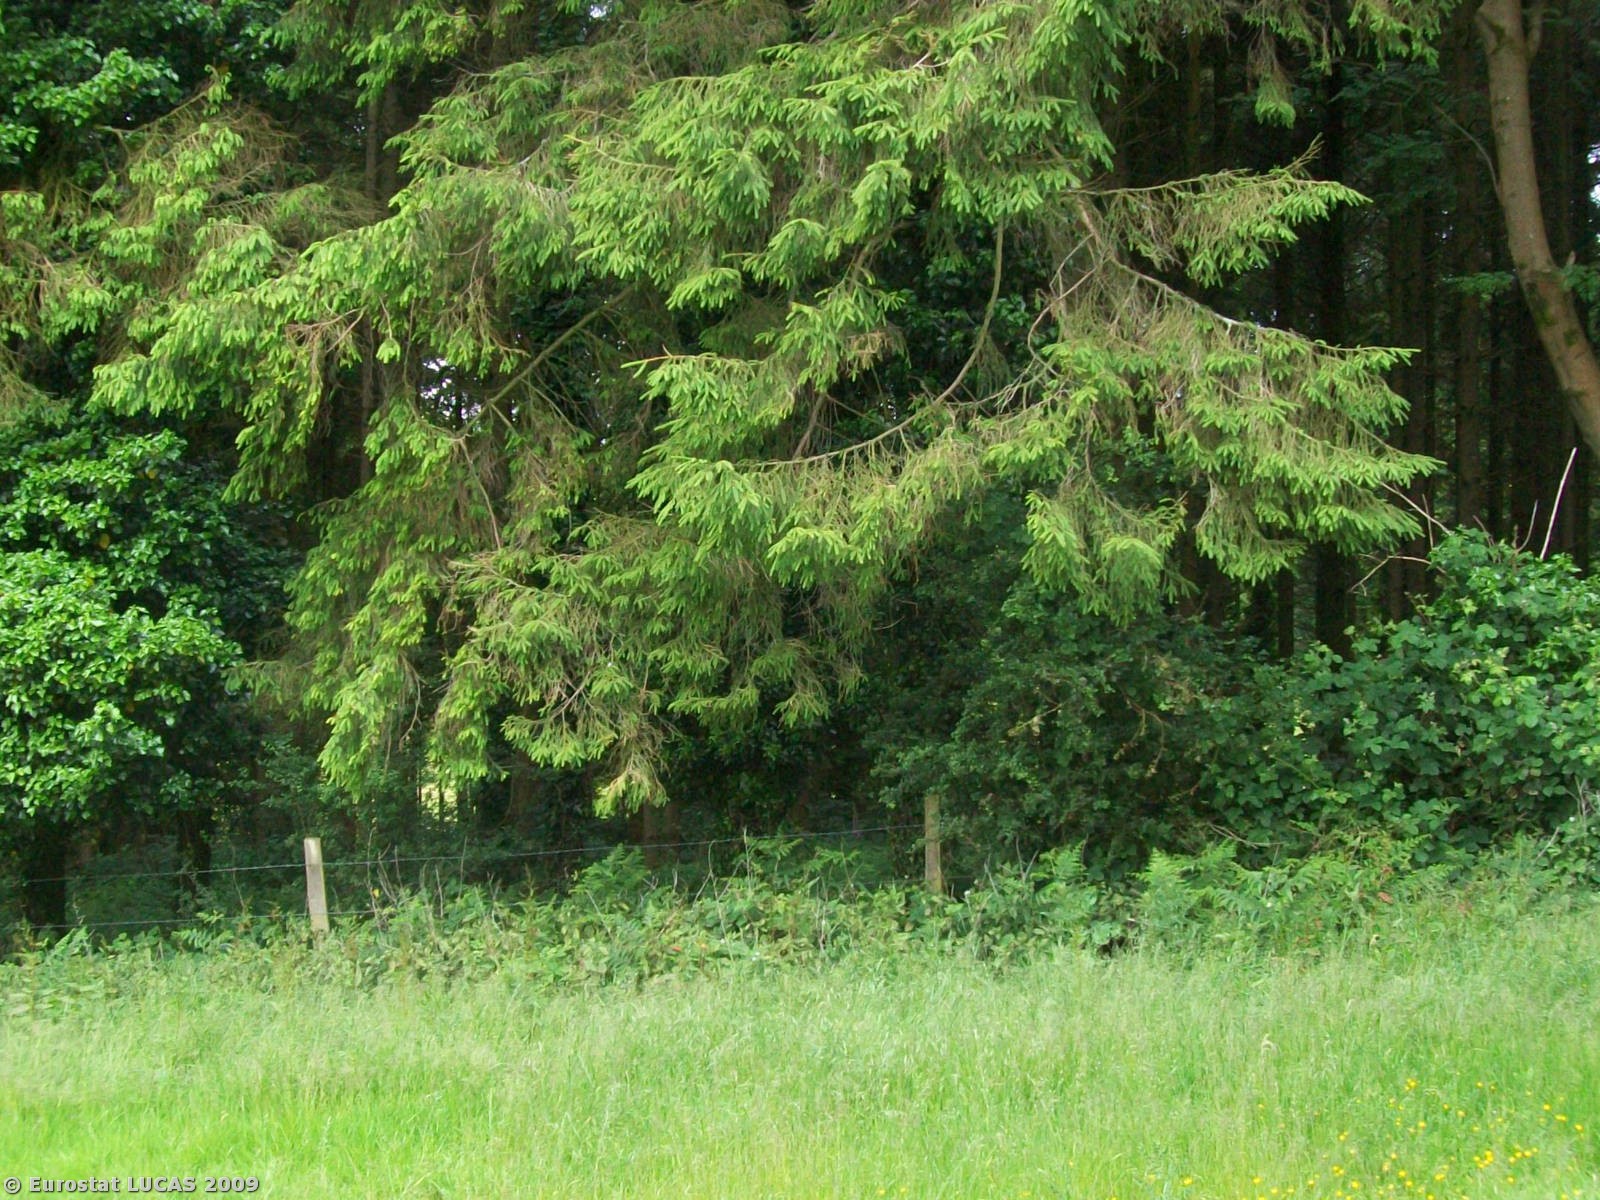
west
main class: Cropland
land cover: Common wheat
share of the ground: > 75 %
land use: Agriculture (excluding fallow land and kitchen gardens)
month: June
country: GB
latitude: 50.8956
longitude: -0.6896
